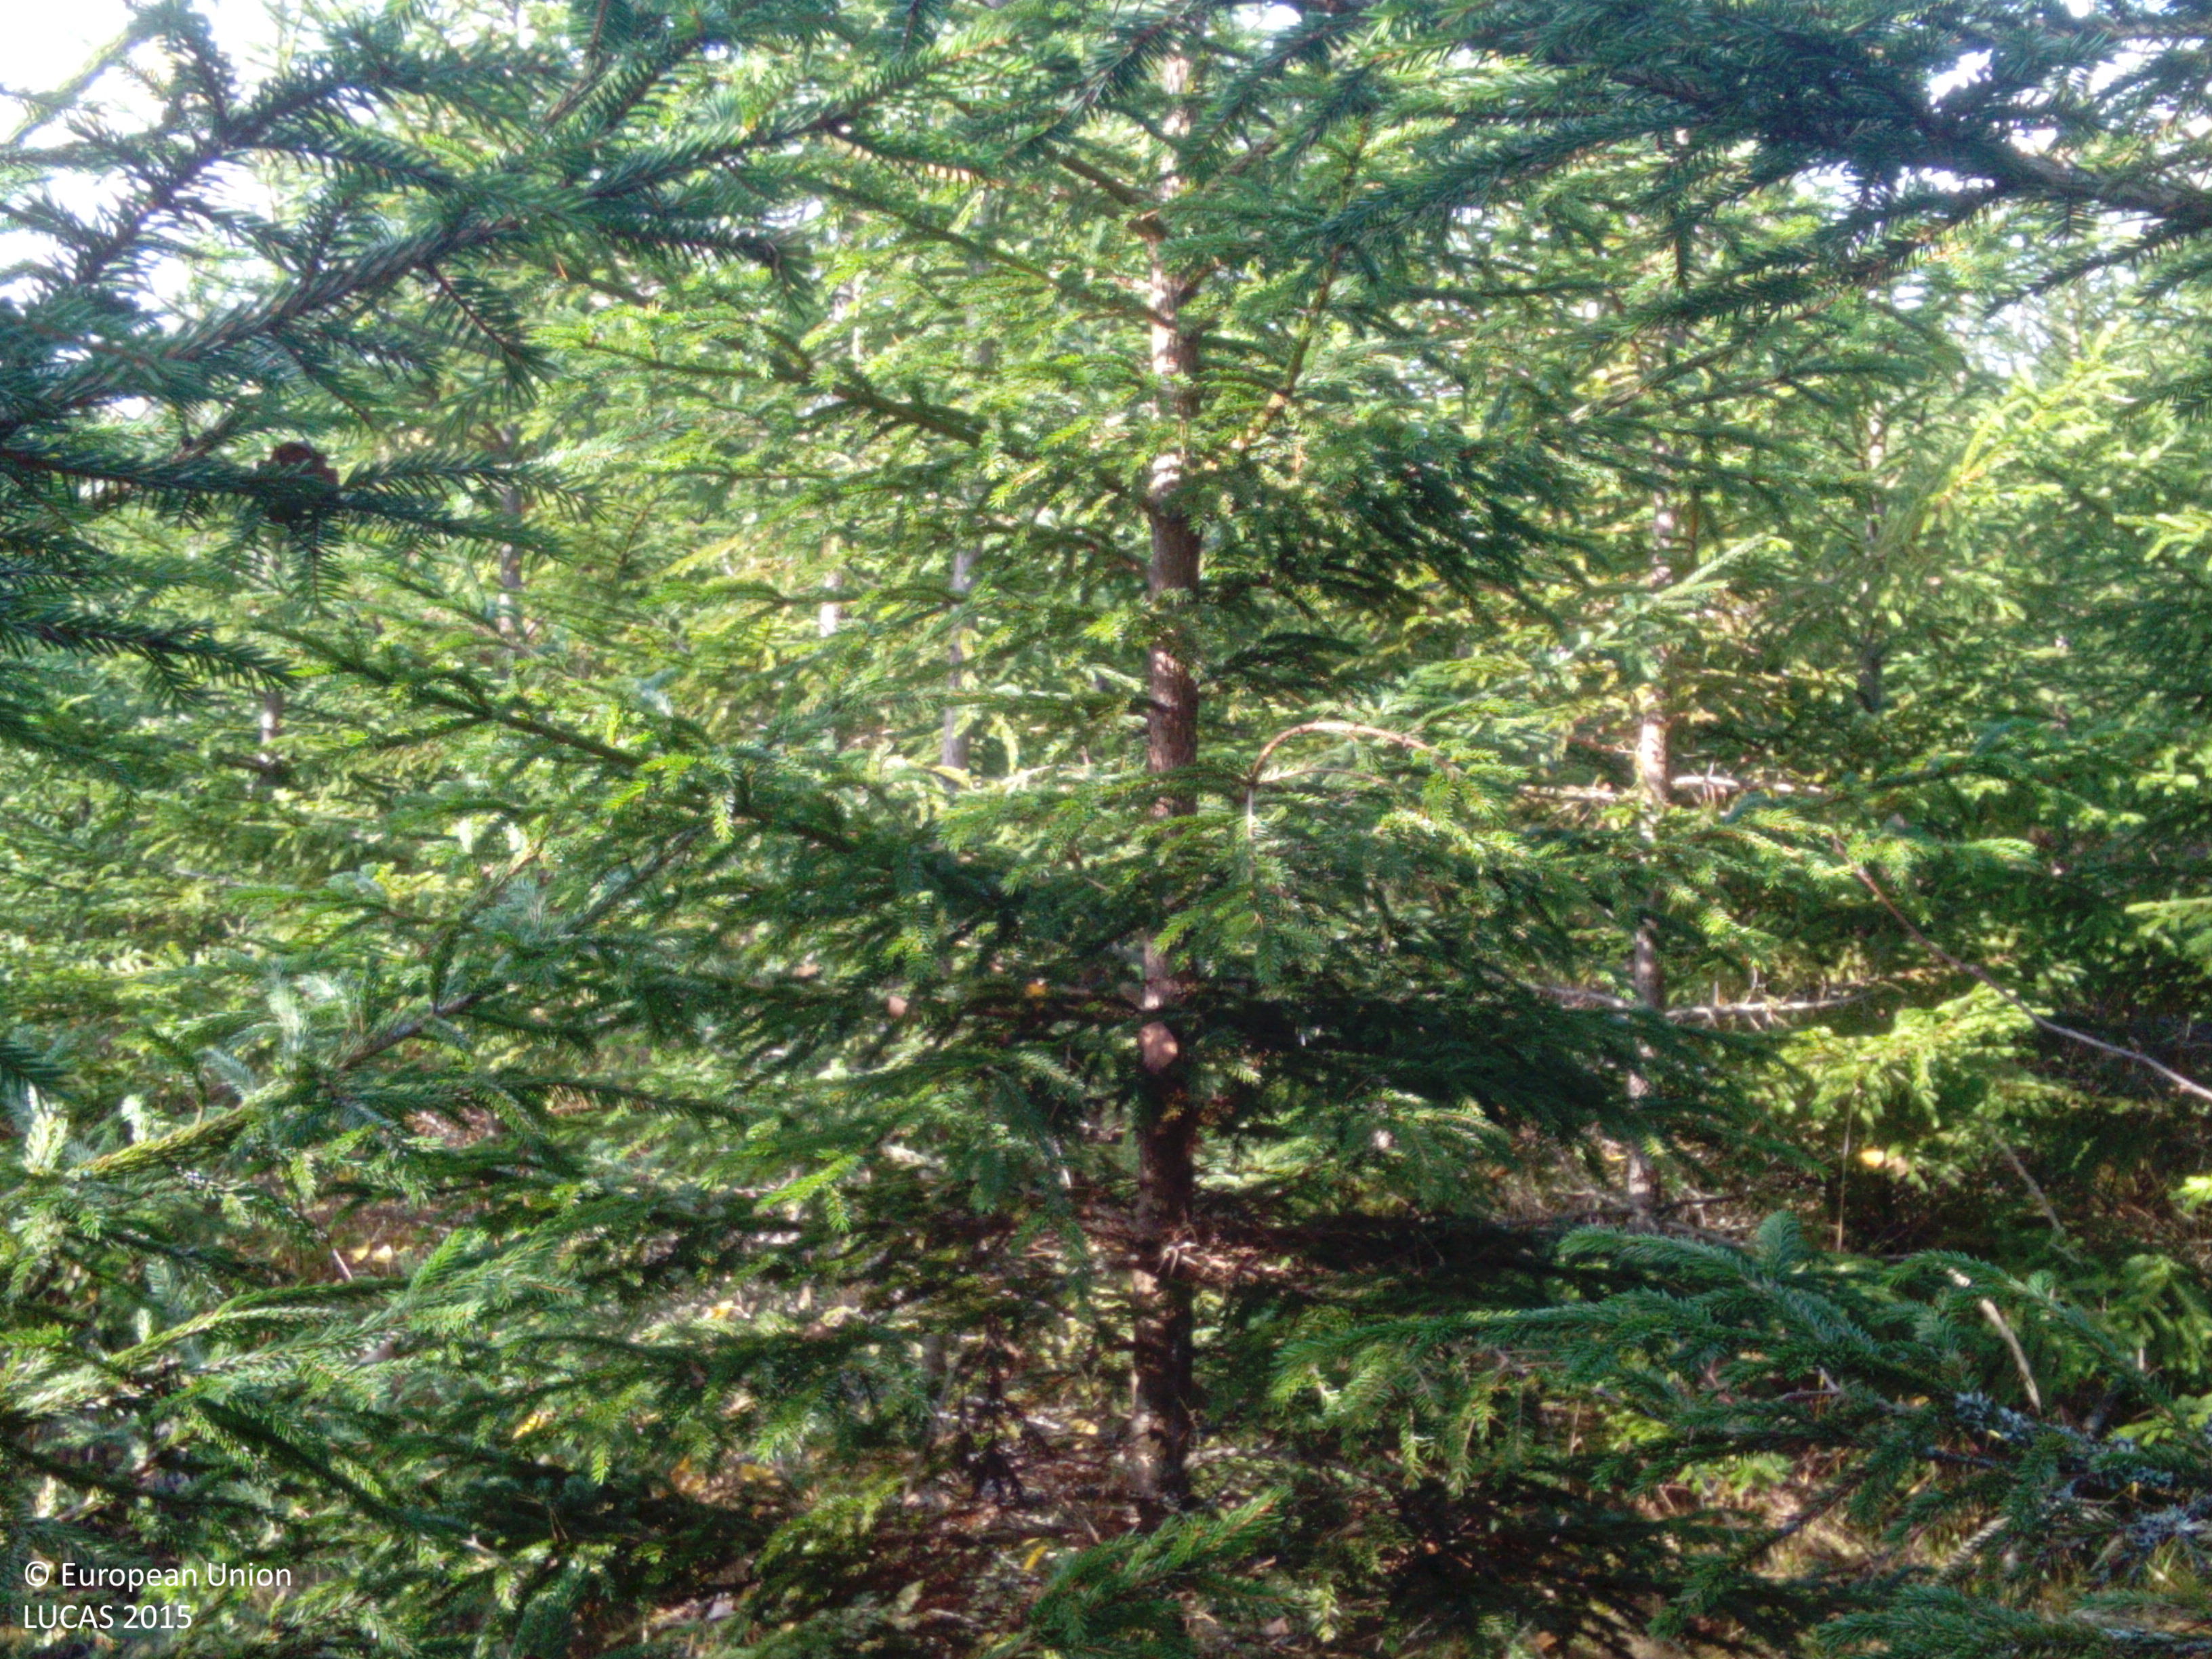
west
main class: Woodland
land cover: Spruce dominated mixed woodland
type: boreal forest
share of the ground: > 75 %
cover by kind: coniferous forest trees 70 %, broadleaved forest trees 25 %, herbaceous plants 5 %
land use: Forestry
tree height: > 5 m
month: October
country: SE
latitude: 59.0114
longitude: 16.6640
